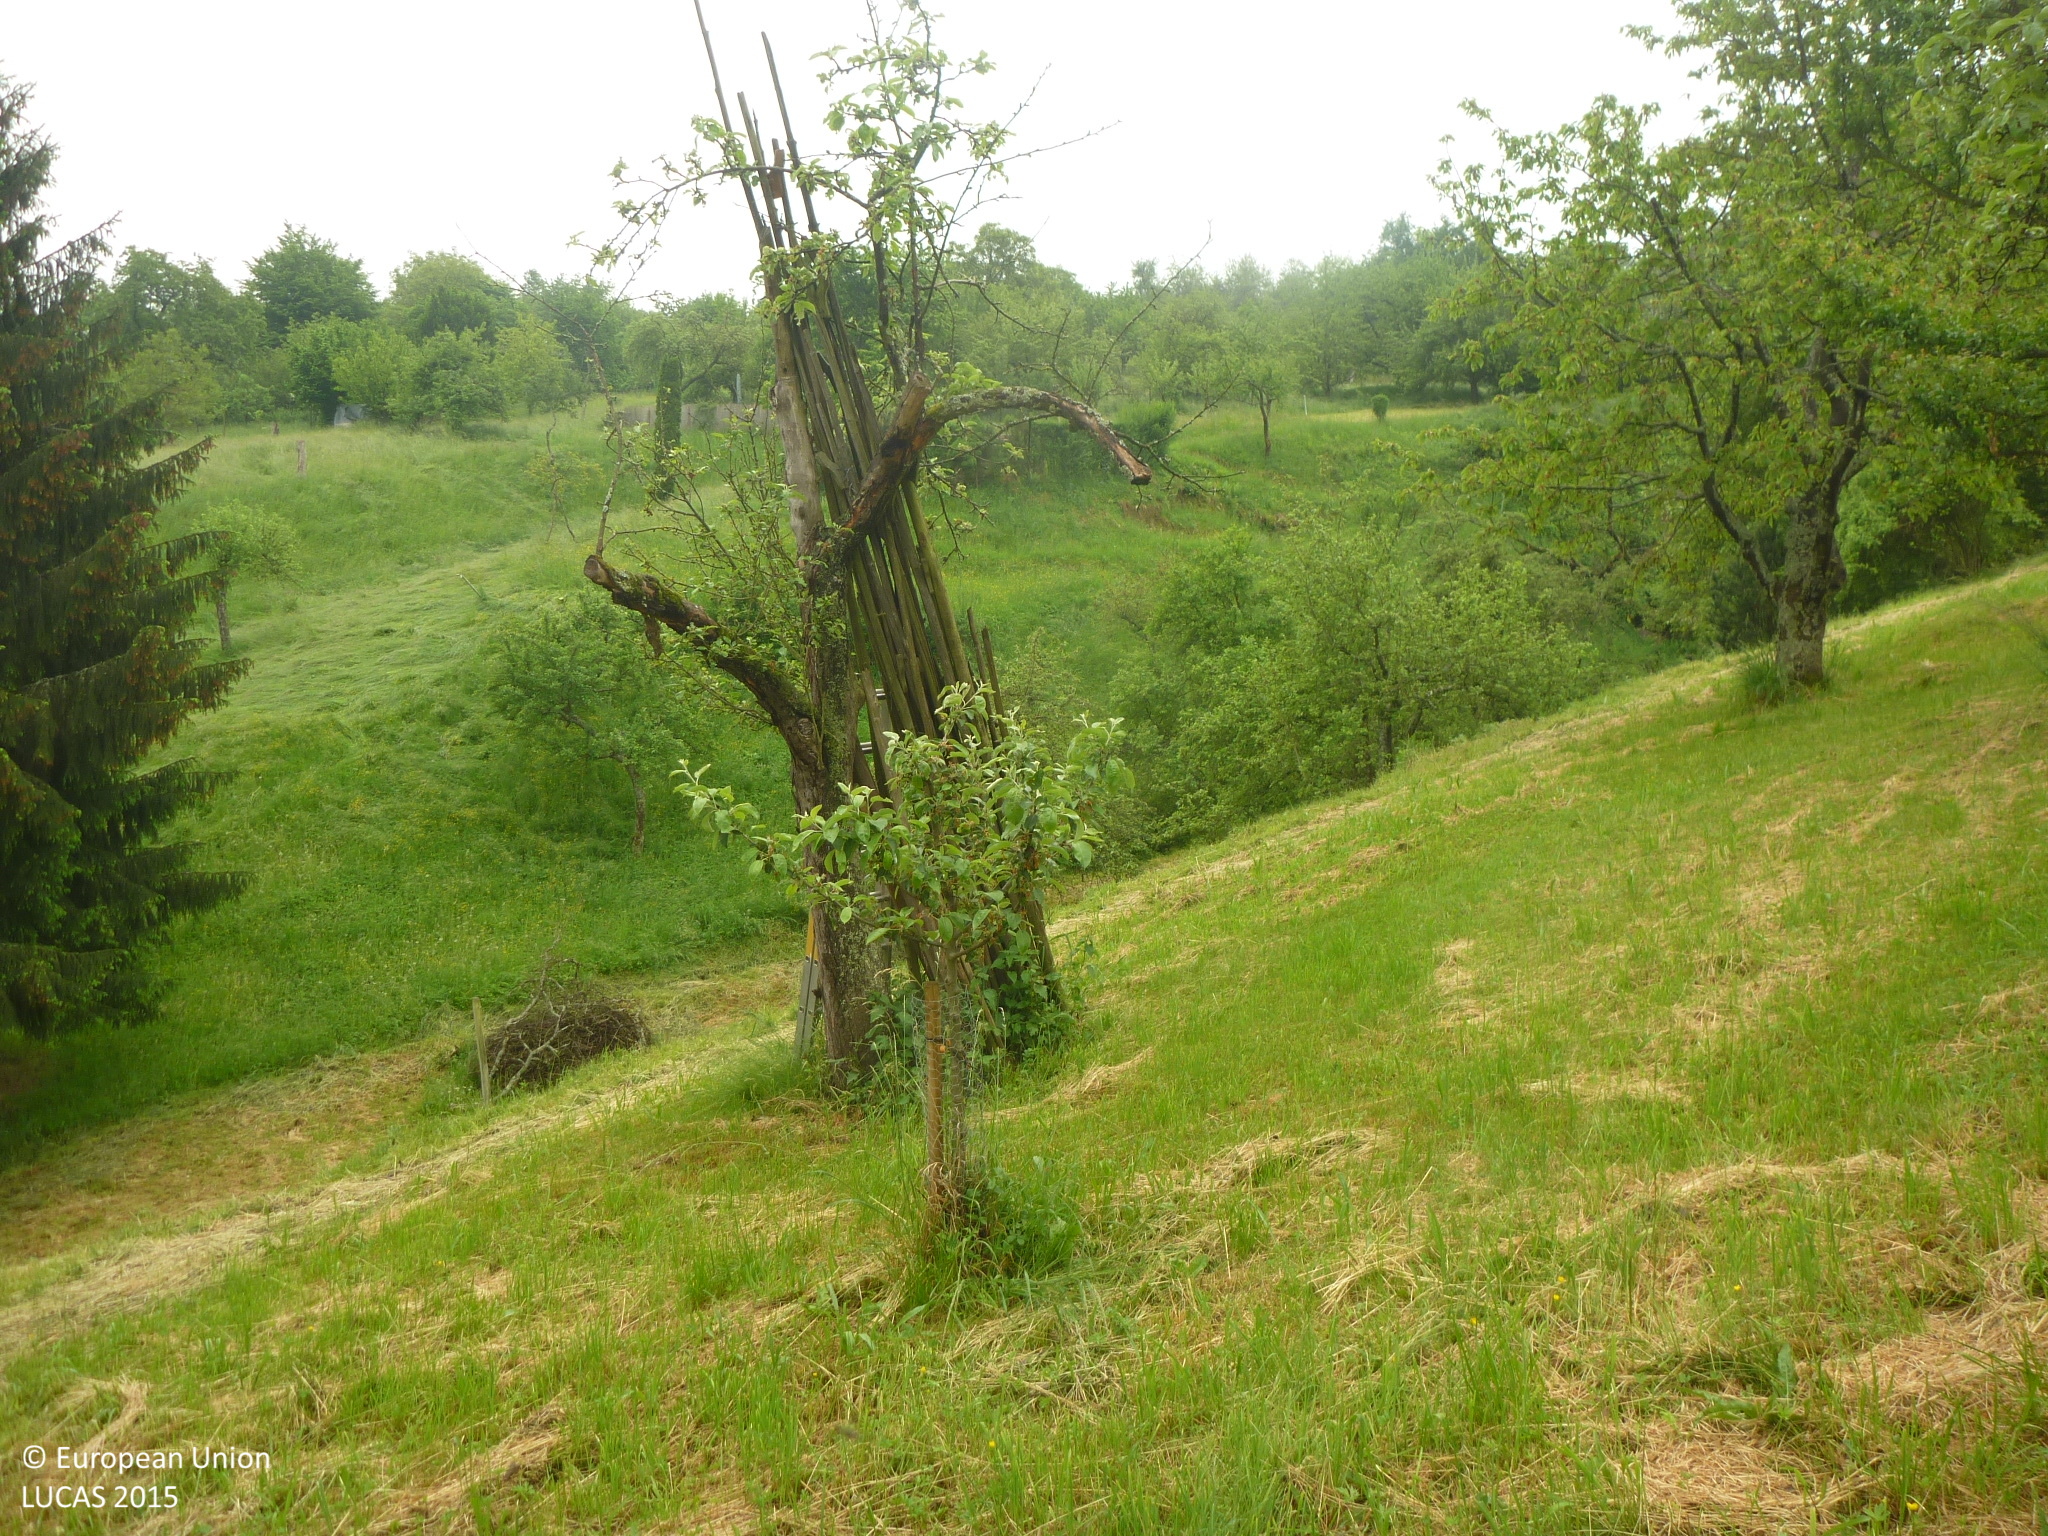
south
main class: Cropland
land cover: Apple fruit
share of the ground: 50 - 75 %
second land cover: Grassland without tree/shrub cover
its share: > 75 %
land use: Agriculture (excluding fallow land and kitchen gardens)
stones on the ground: < 10 %
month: May
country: DE
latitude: 48.7793
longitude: 9.3335
